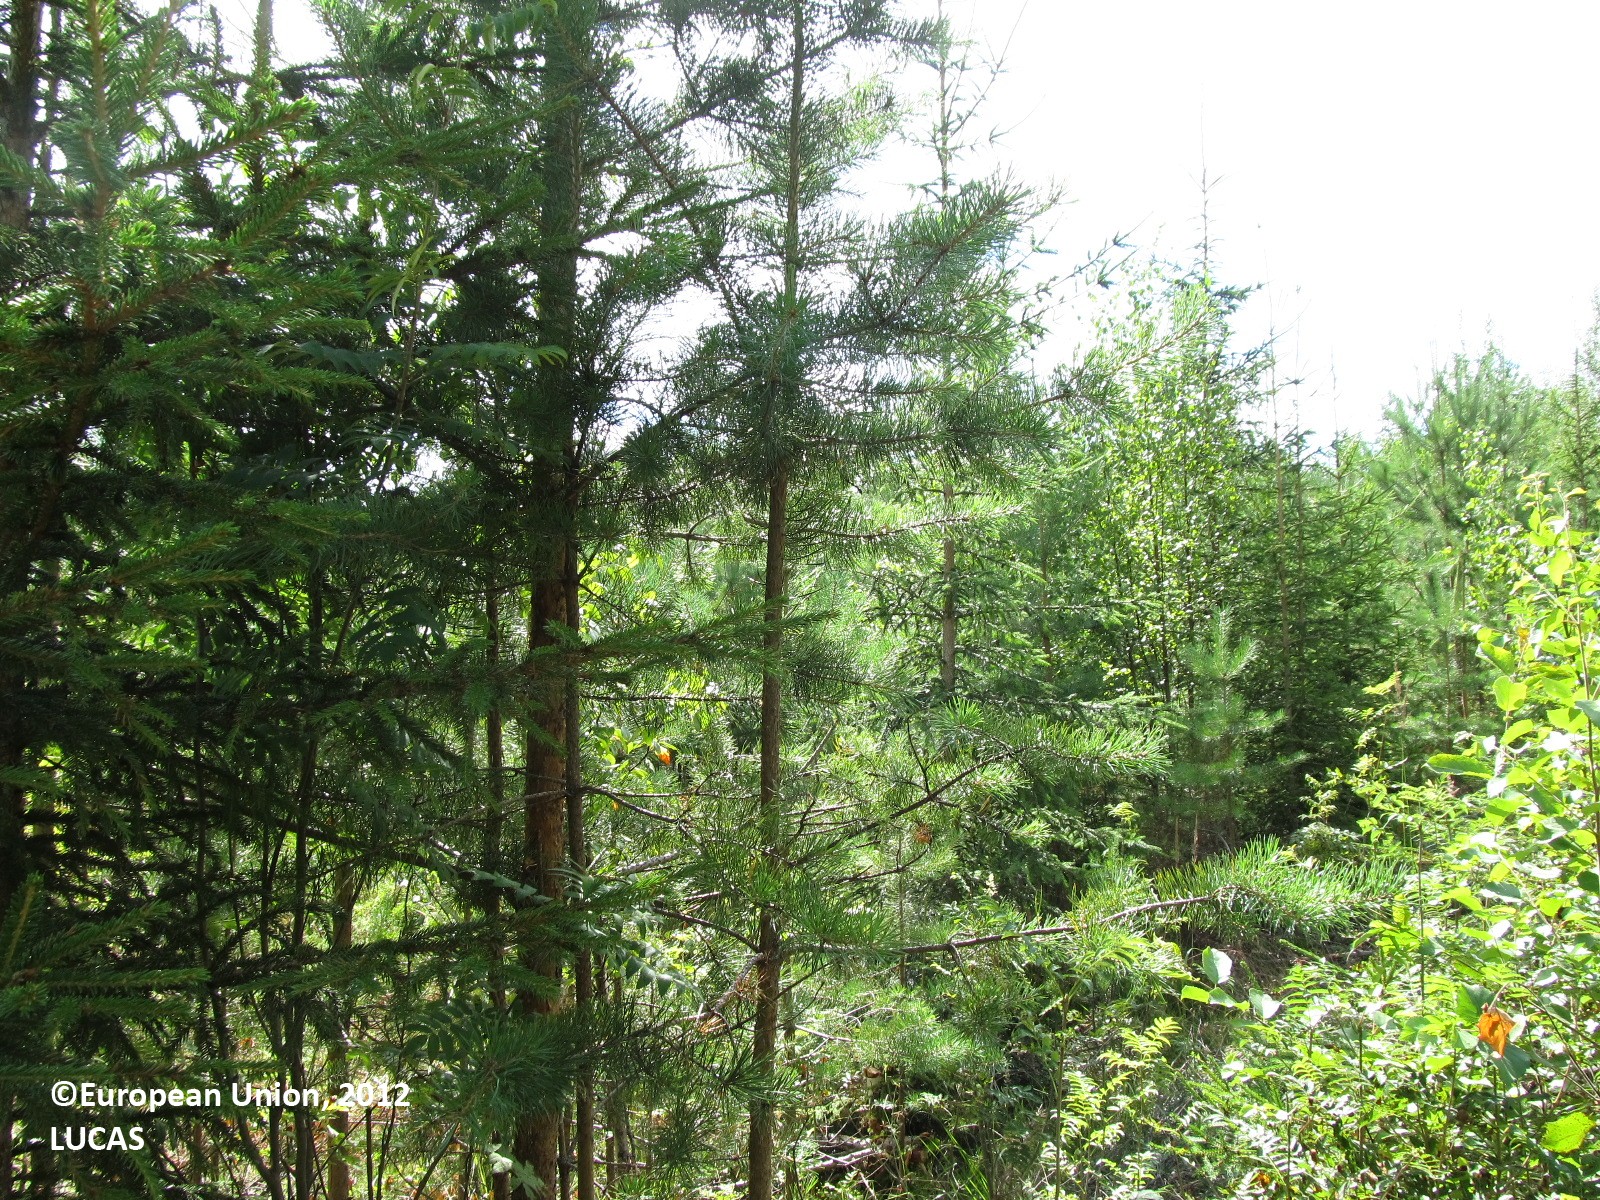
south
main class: Woodland
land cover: Pine dominated mixed woodland
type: boreal forest
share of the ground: 50 - 75 %
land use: Forestry
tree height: < 5 m
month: August
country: FI
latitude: 61.6874
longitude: 27.9378
